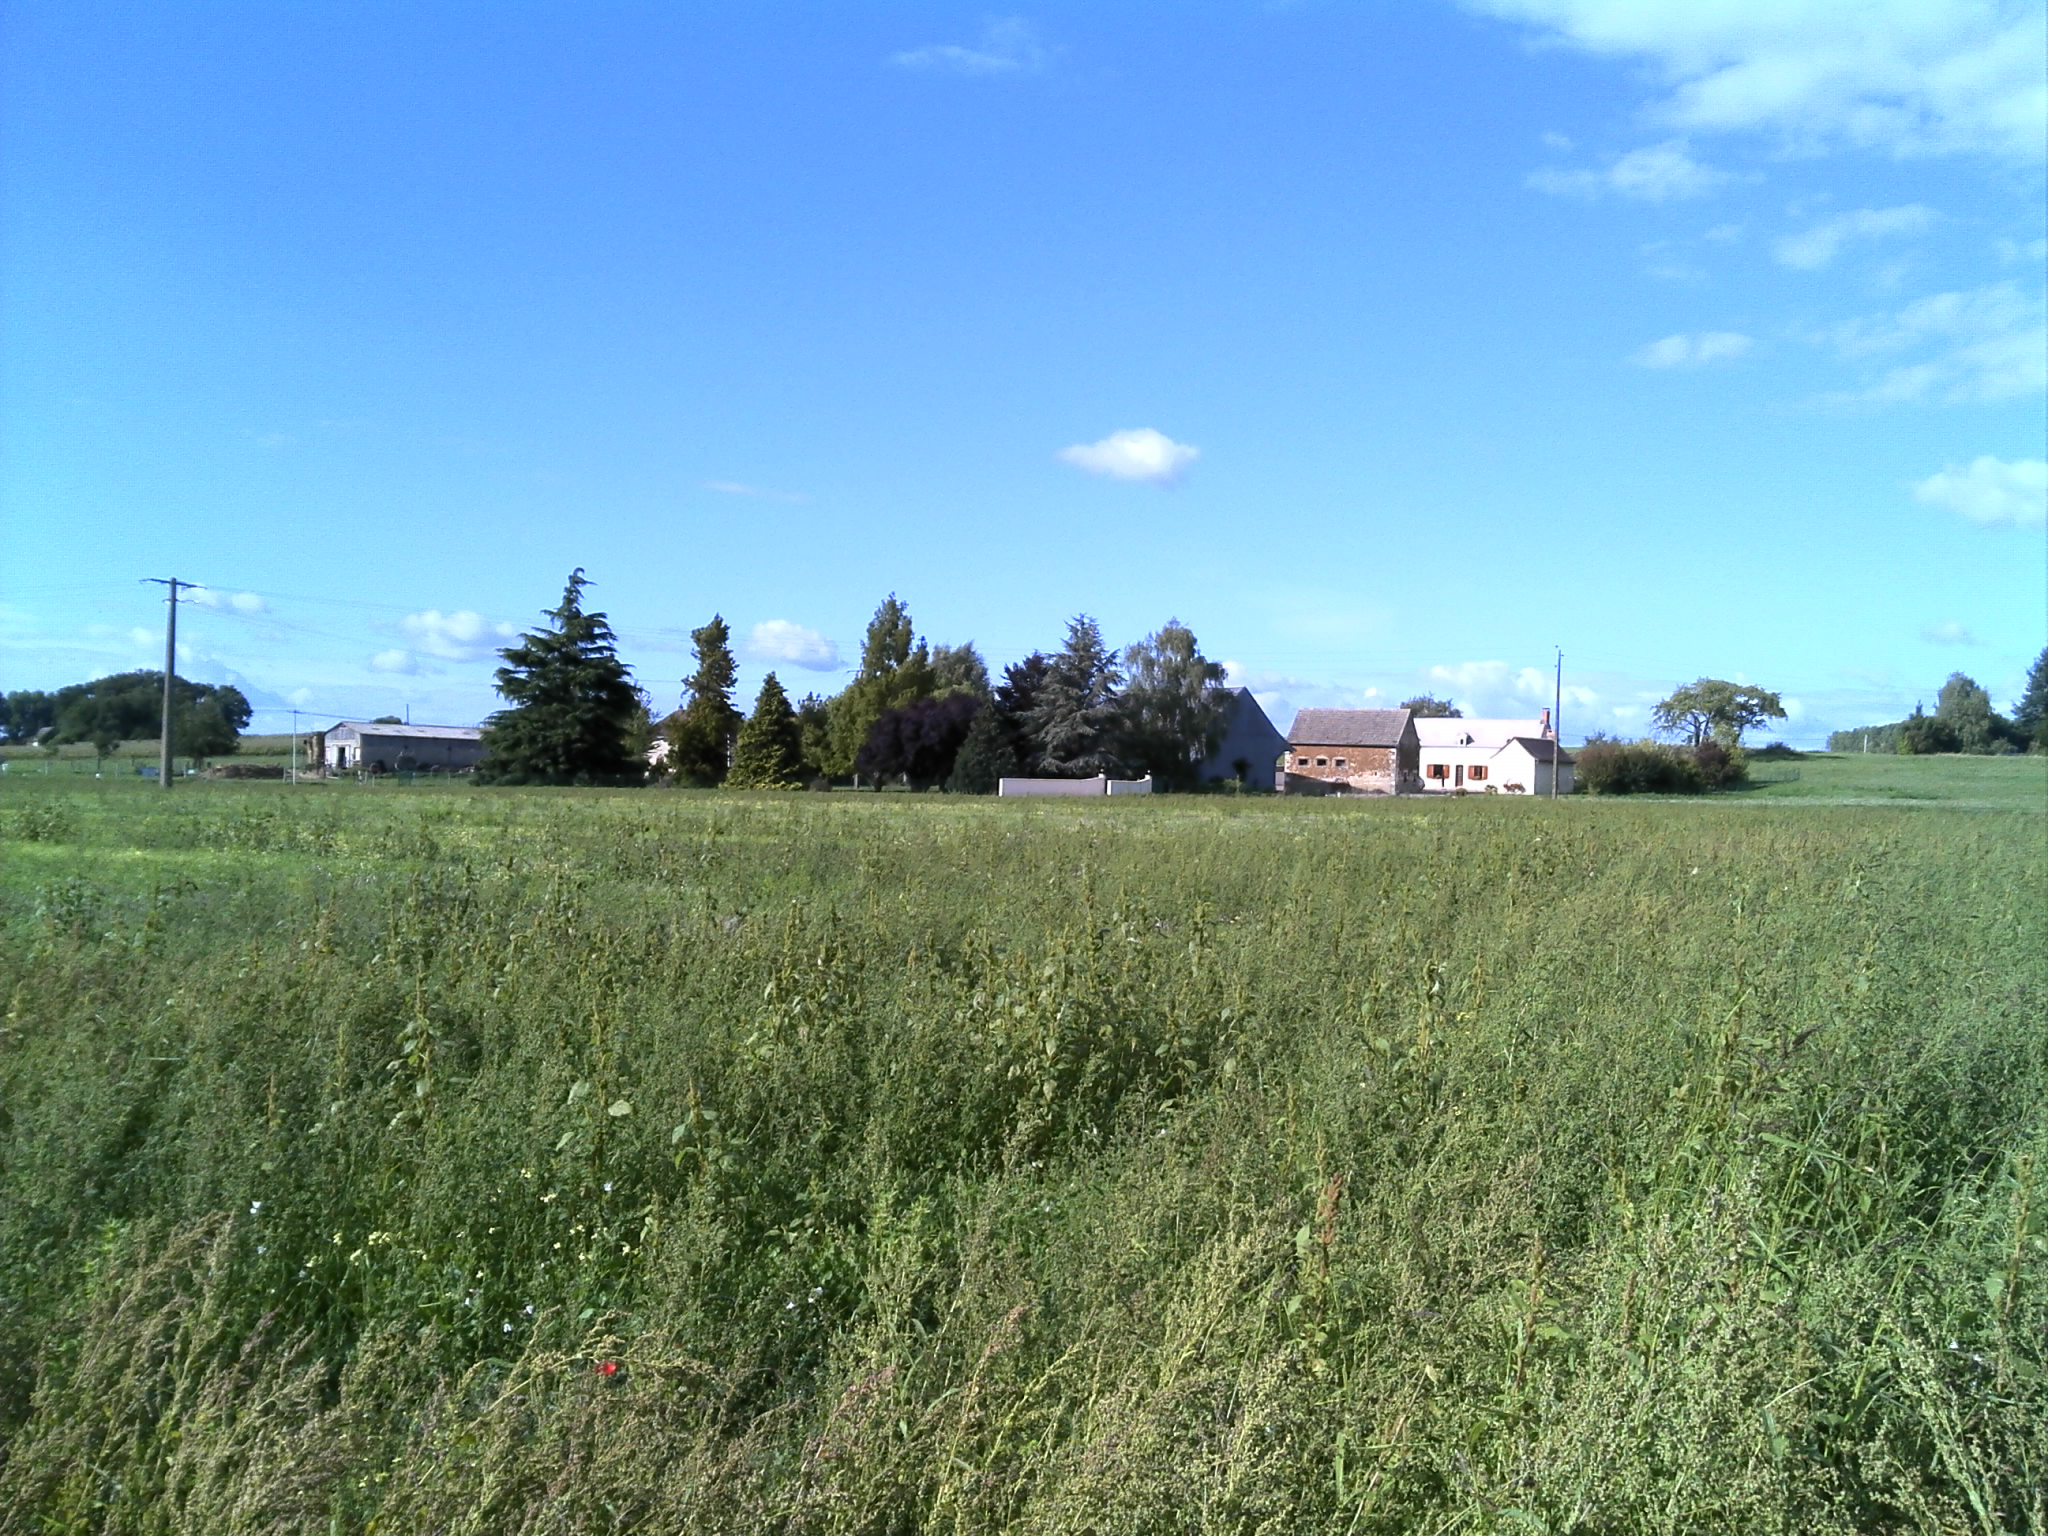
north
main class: Grassland
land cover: Spontaneously vegetated surfaces
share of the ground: > 75 %
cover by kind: herbaceous plants 100 %
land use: Agriculture (excluding fallow land and kitchen gardens)
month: September
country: FR
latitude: 47.7209
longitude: 0.2841
